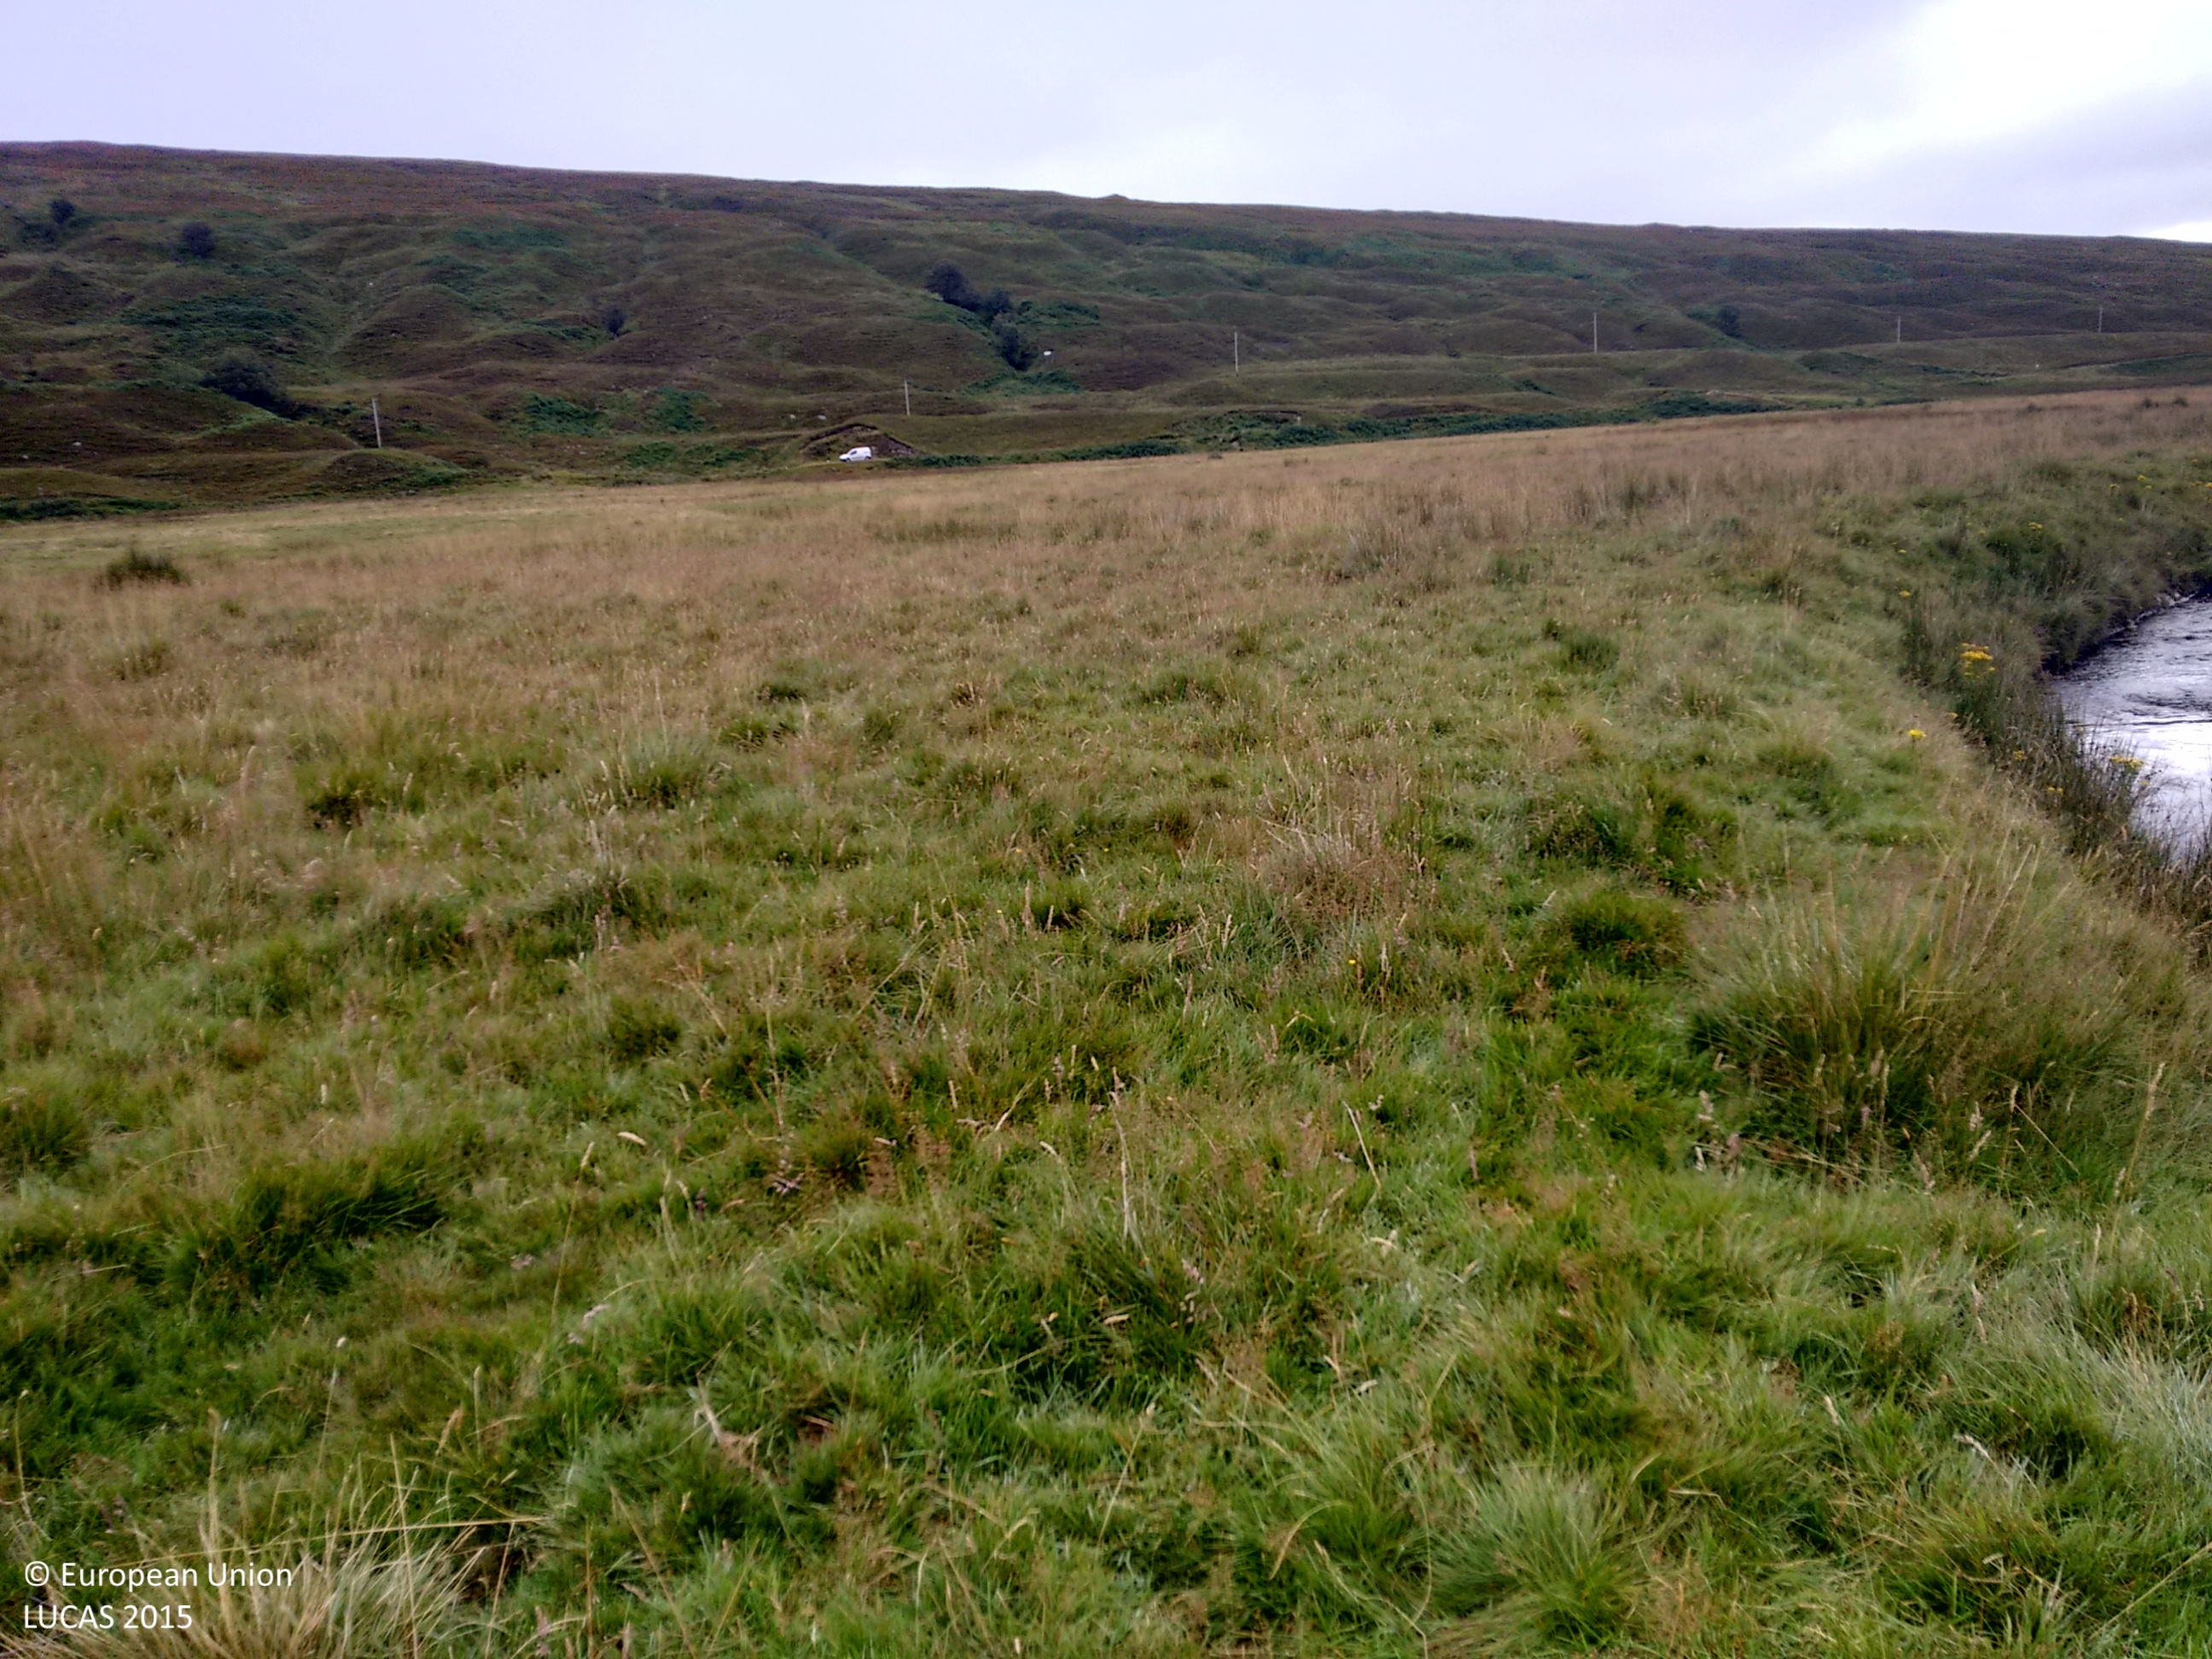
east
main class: Shrubland
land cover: Shrubland without tree cover
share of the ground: > 75 %
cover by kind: shrubs 75 %, herbaceous plants 25 %
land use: Agriculture (excluding fallow land and kitchen gardens)
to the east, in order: Shrubland without tree cover; Grassland without tree/shrub cover; Rivers and streams; Grassland without tree/shrub cover
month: September
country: GB
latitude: 58.0977
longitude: -4.7341
